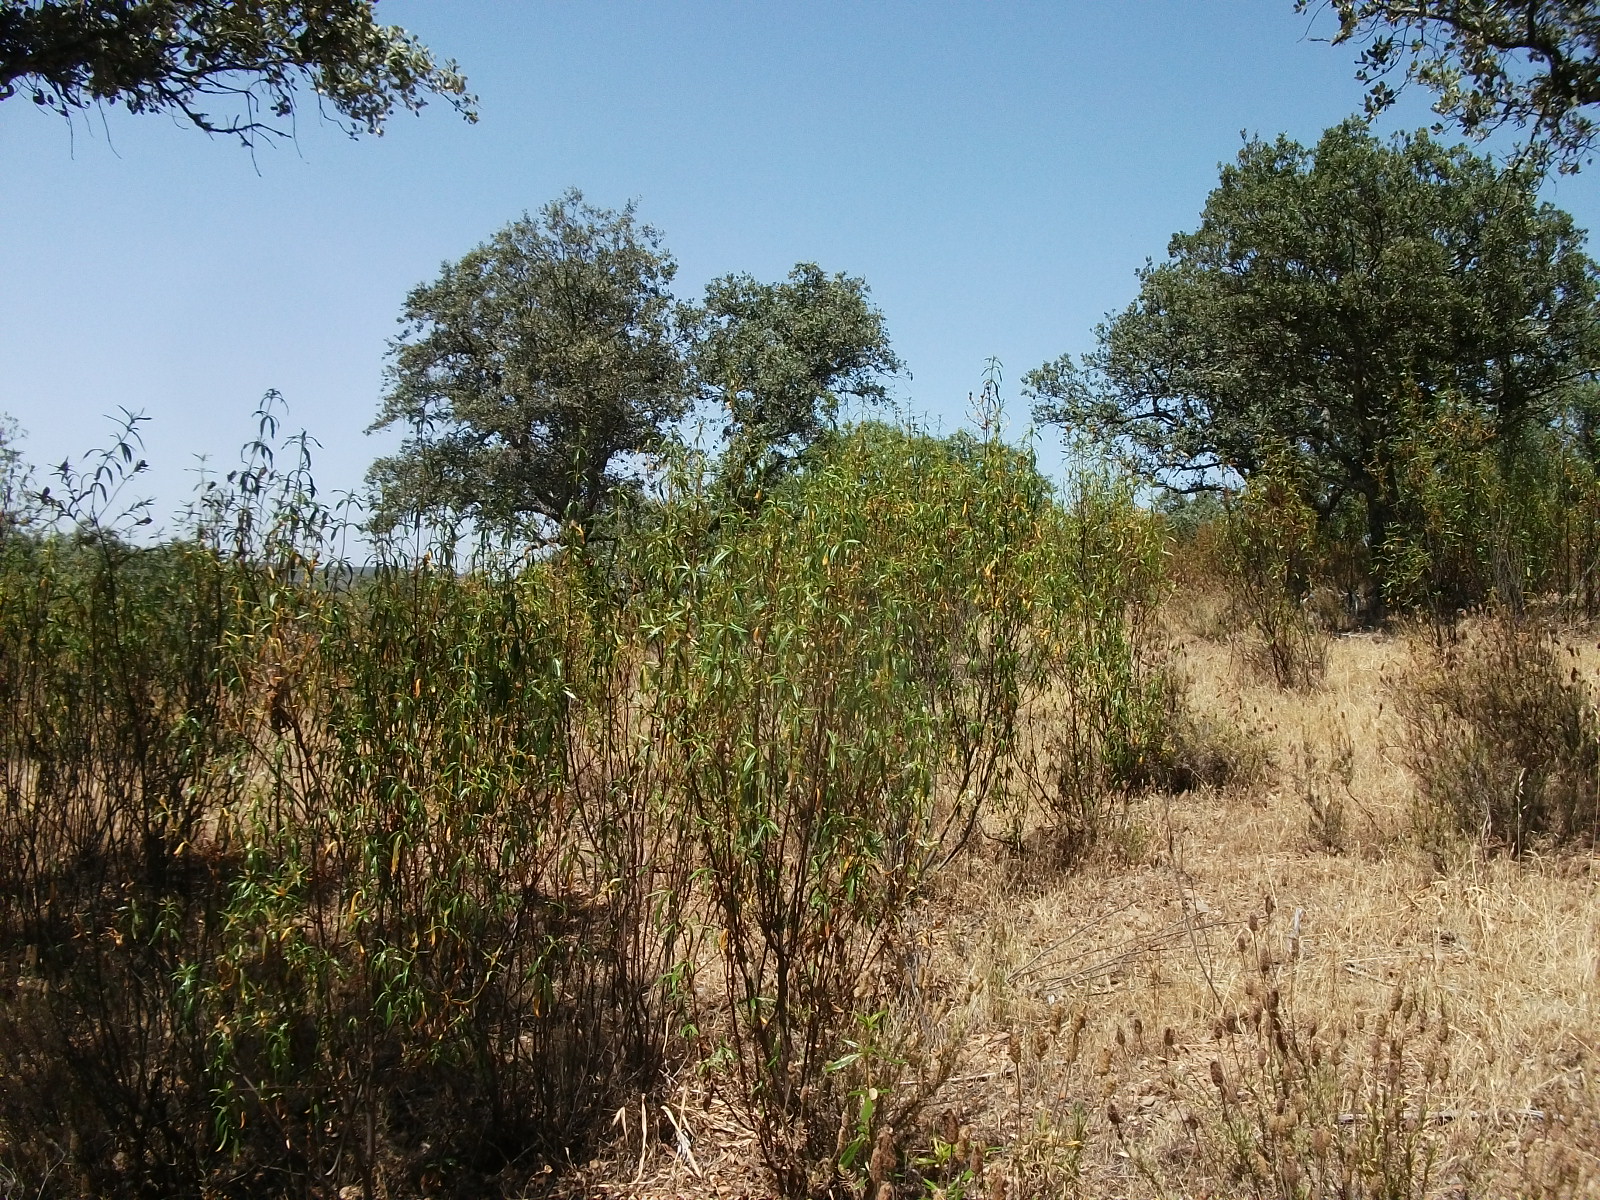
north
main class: Woodland
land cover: Broadleaved woodland
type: broadleaved evergreen forest
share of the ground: 50 - 75 %
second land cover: Spontaneously vegetated surfaces
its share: 25 - 50 %
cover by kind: broadleaved forest trees 60 %, shrubs 30 %, herbaceous plants 10 %
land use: Forestry
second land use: Agriculture (excluding fallow land and kitchen gardens)
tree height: > 5 m
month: June
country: ES
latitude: 37.5453
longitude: -6.9422
